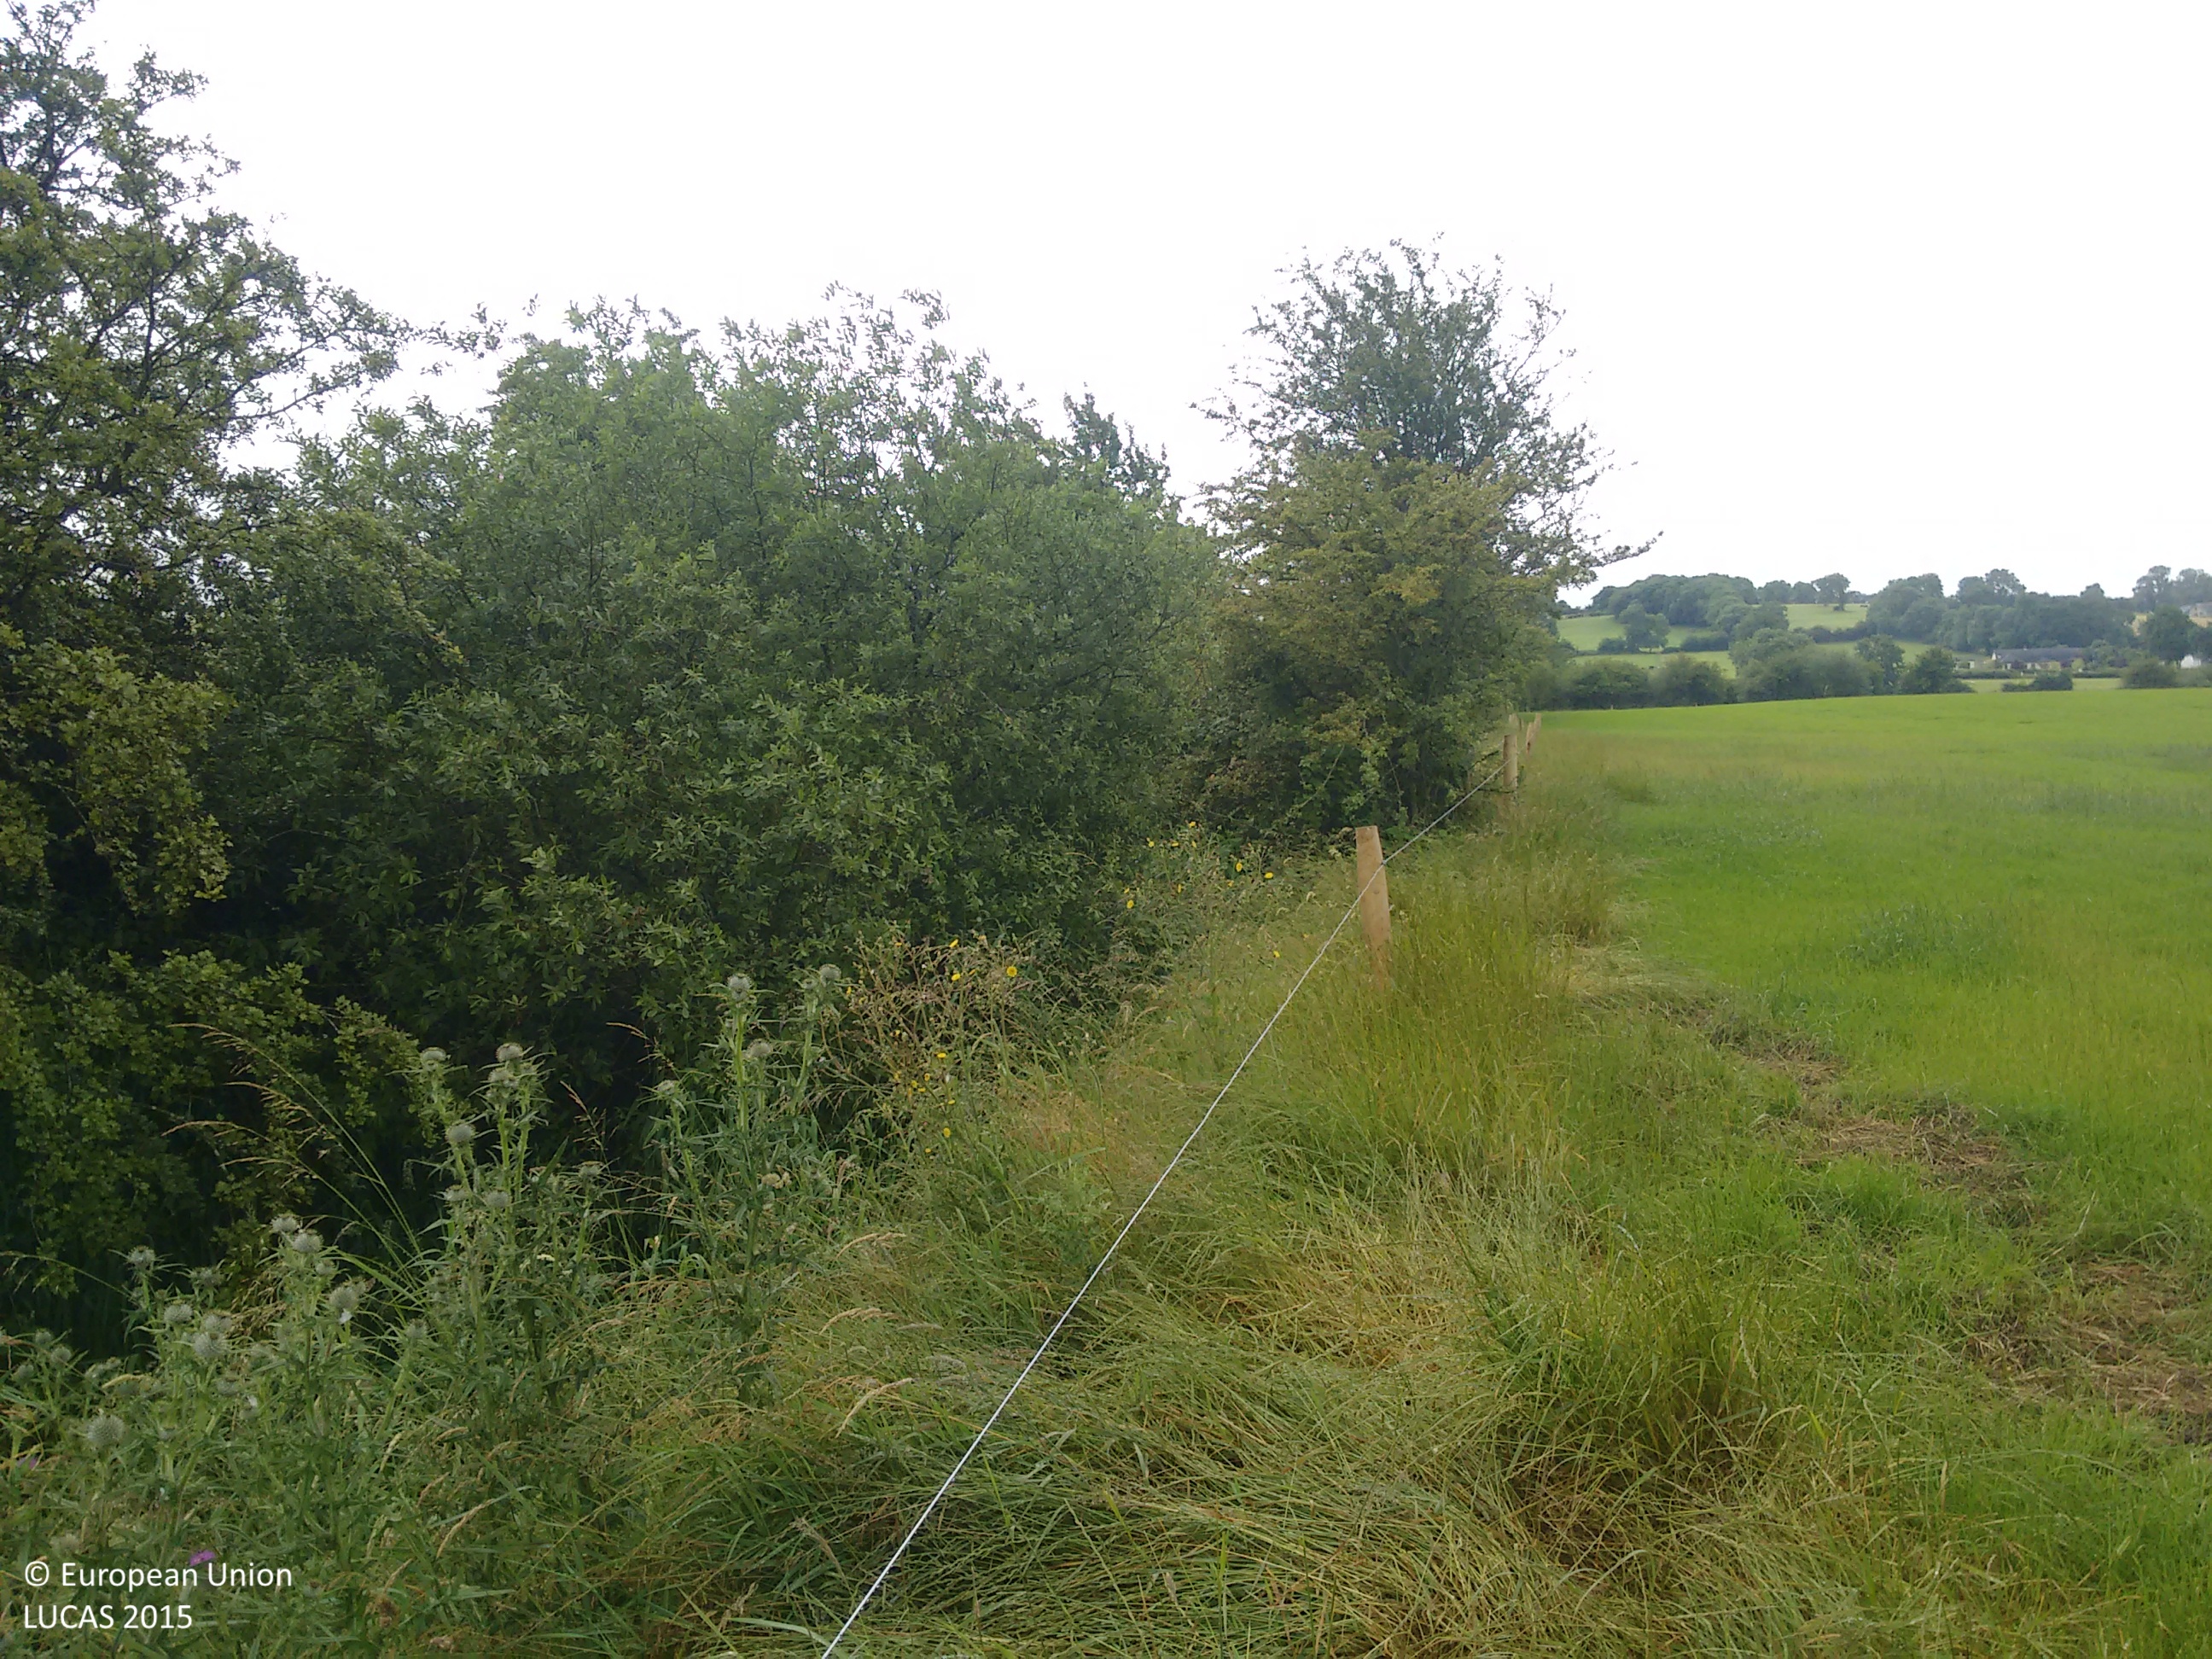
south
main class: Grassland
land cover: Grassland without tree/shrub cover
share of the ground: > 75 %
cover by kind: herbaceous plants 100 %
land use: Agriculture (excluding fallow land and kitchen gardens)
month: July
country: IE
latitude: 53.4806
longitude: -7.8452
